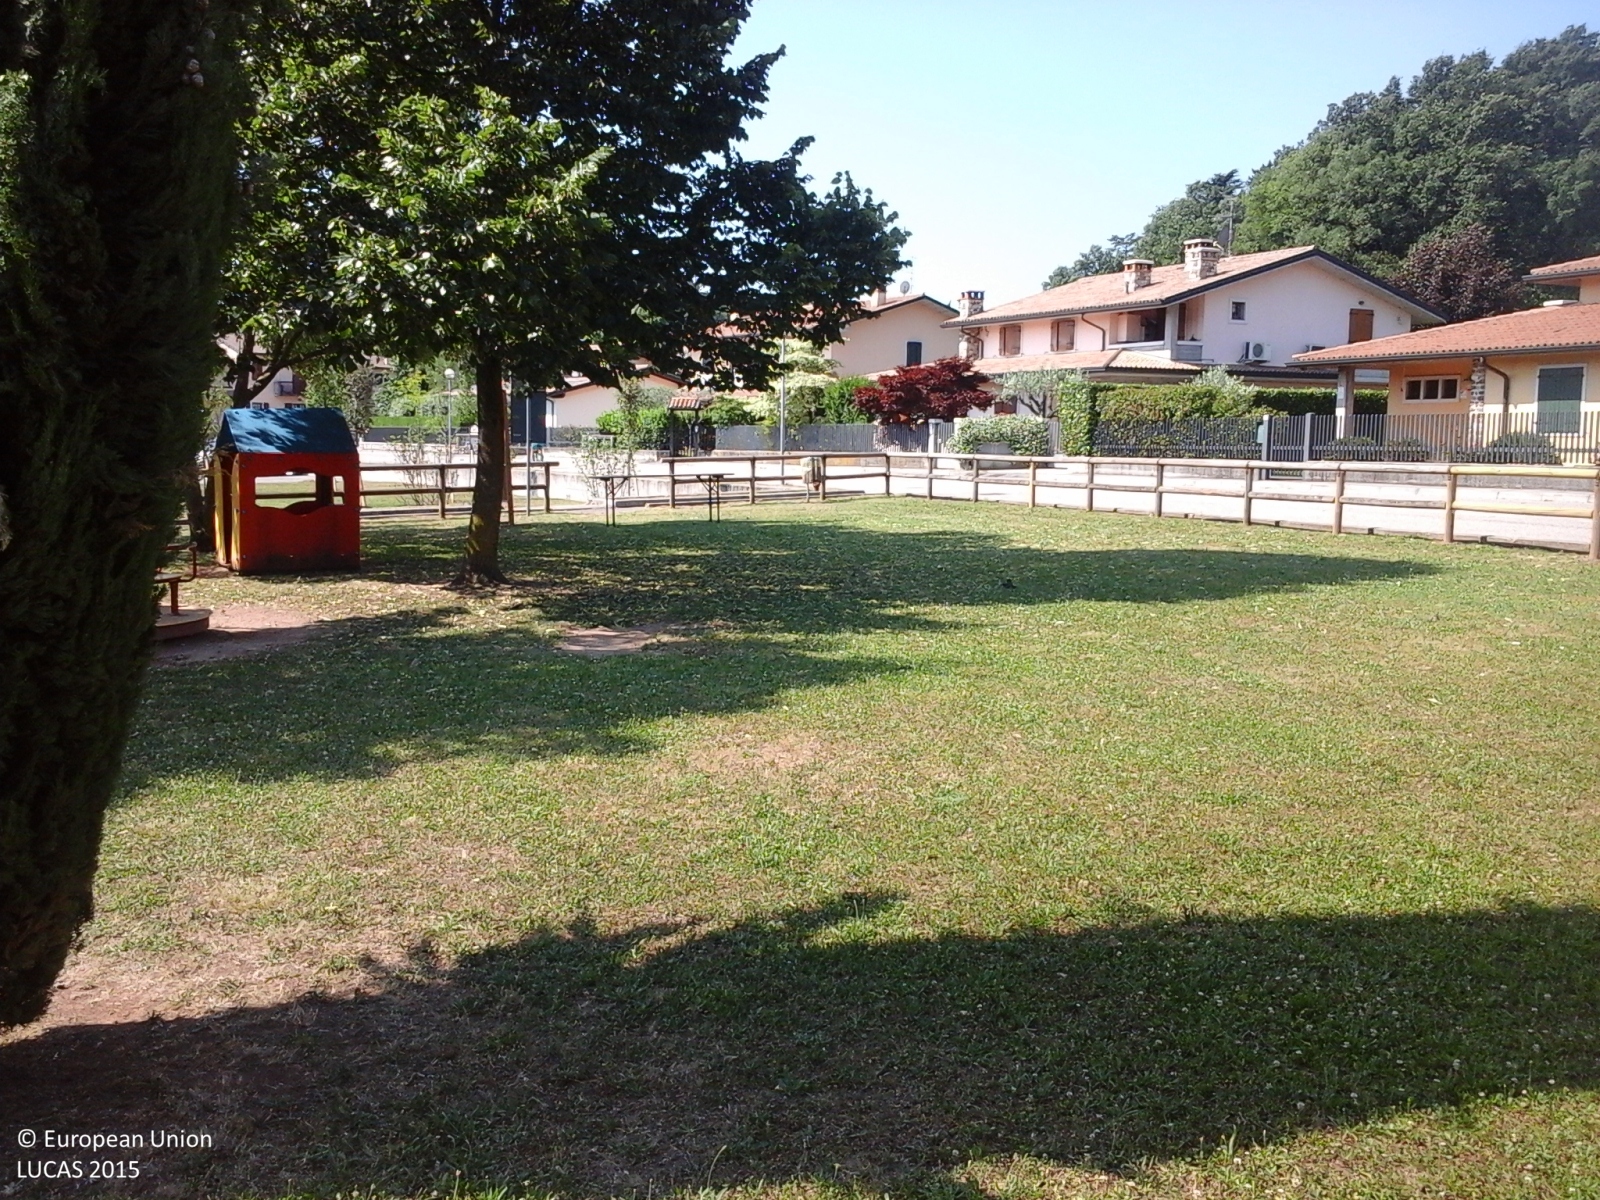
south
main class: Grassland
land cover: Grassland with sparse tree/shrub cover
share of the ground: > 75 %
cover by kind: herbaceous plants 85 %, shrubs 10 %, broadleaved forest trees 5 %
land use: Amenities, museums, leisure
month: June
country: IT
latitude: 45.5738
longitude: 10.7548
